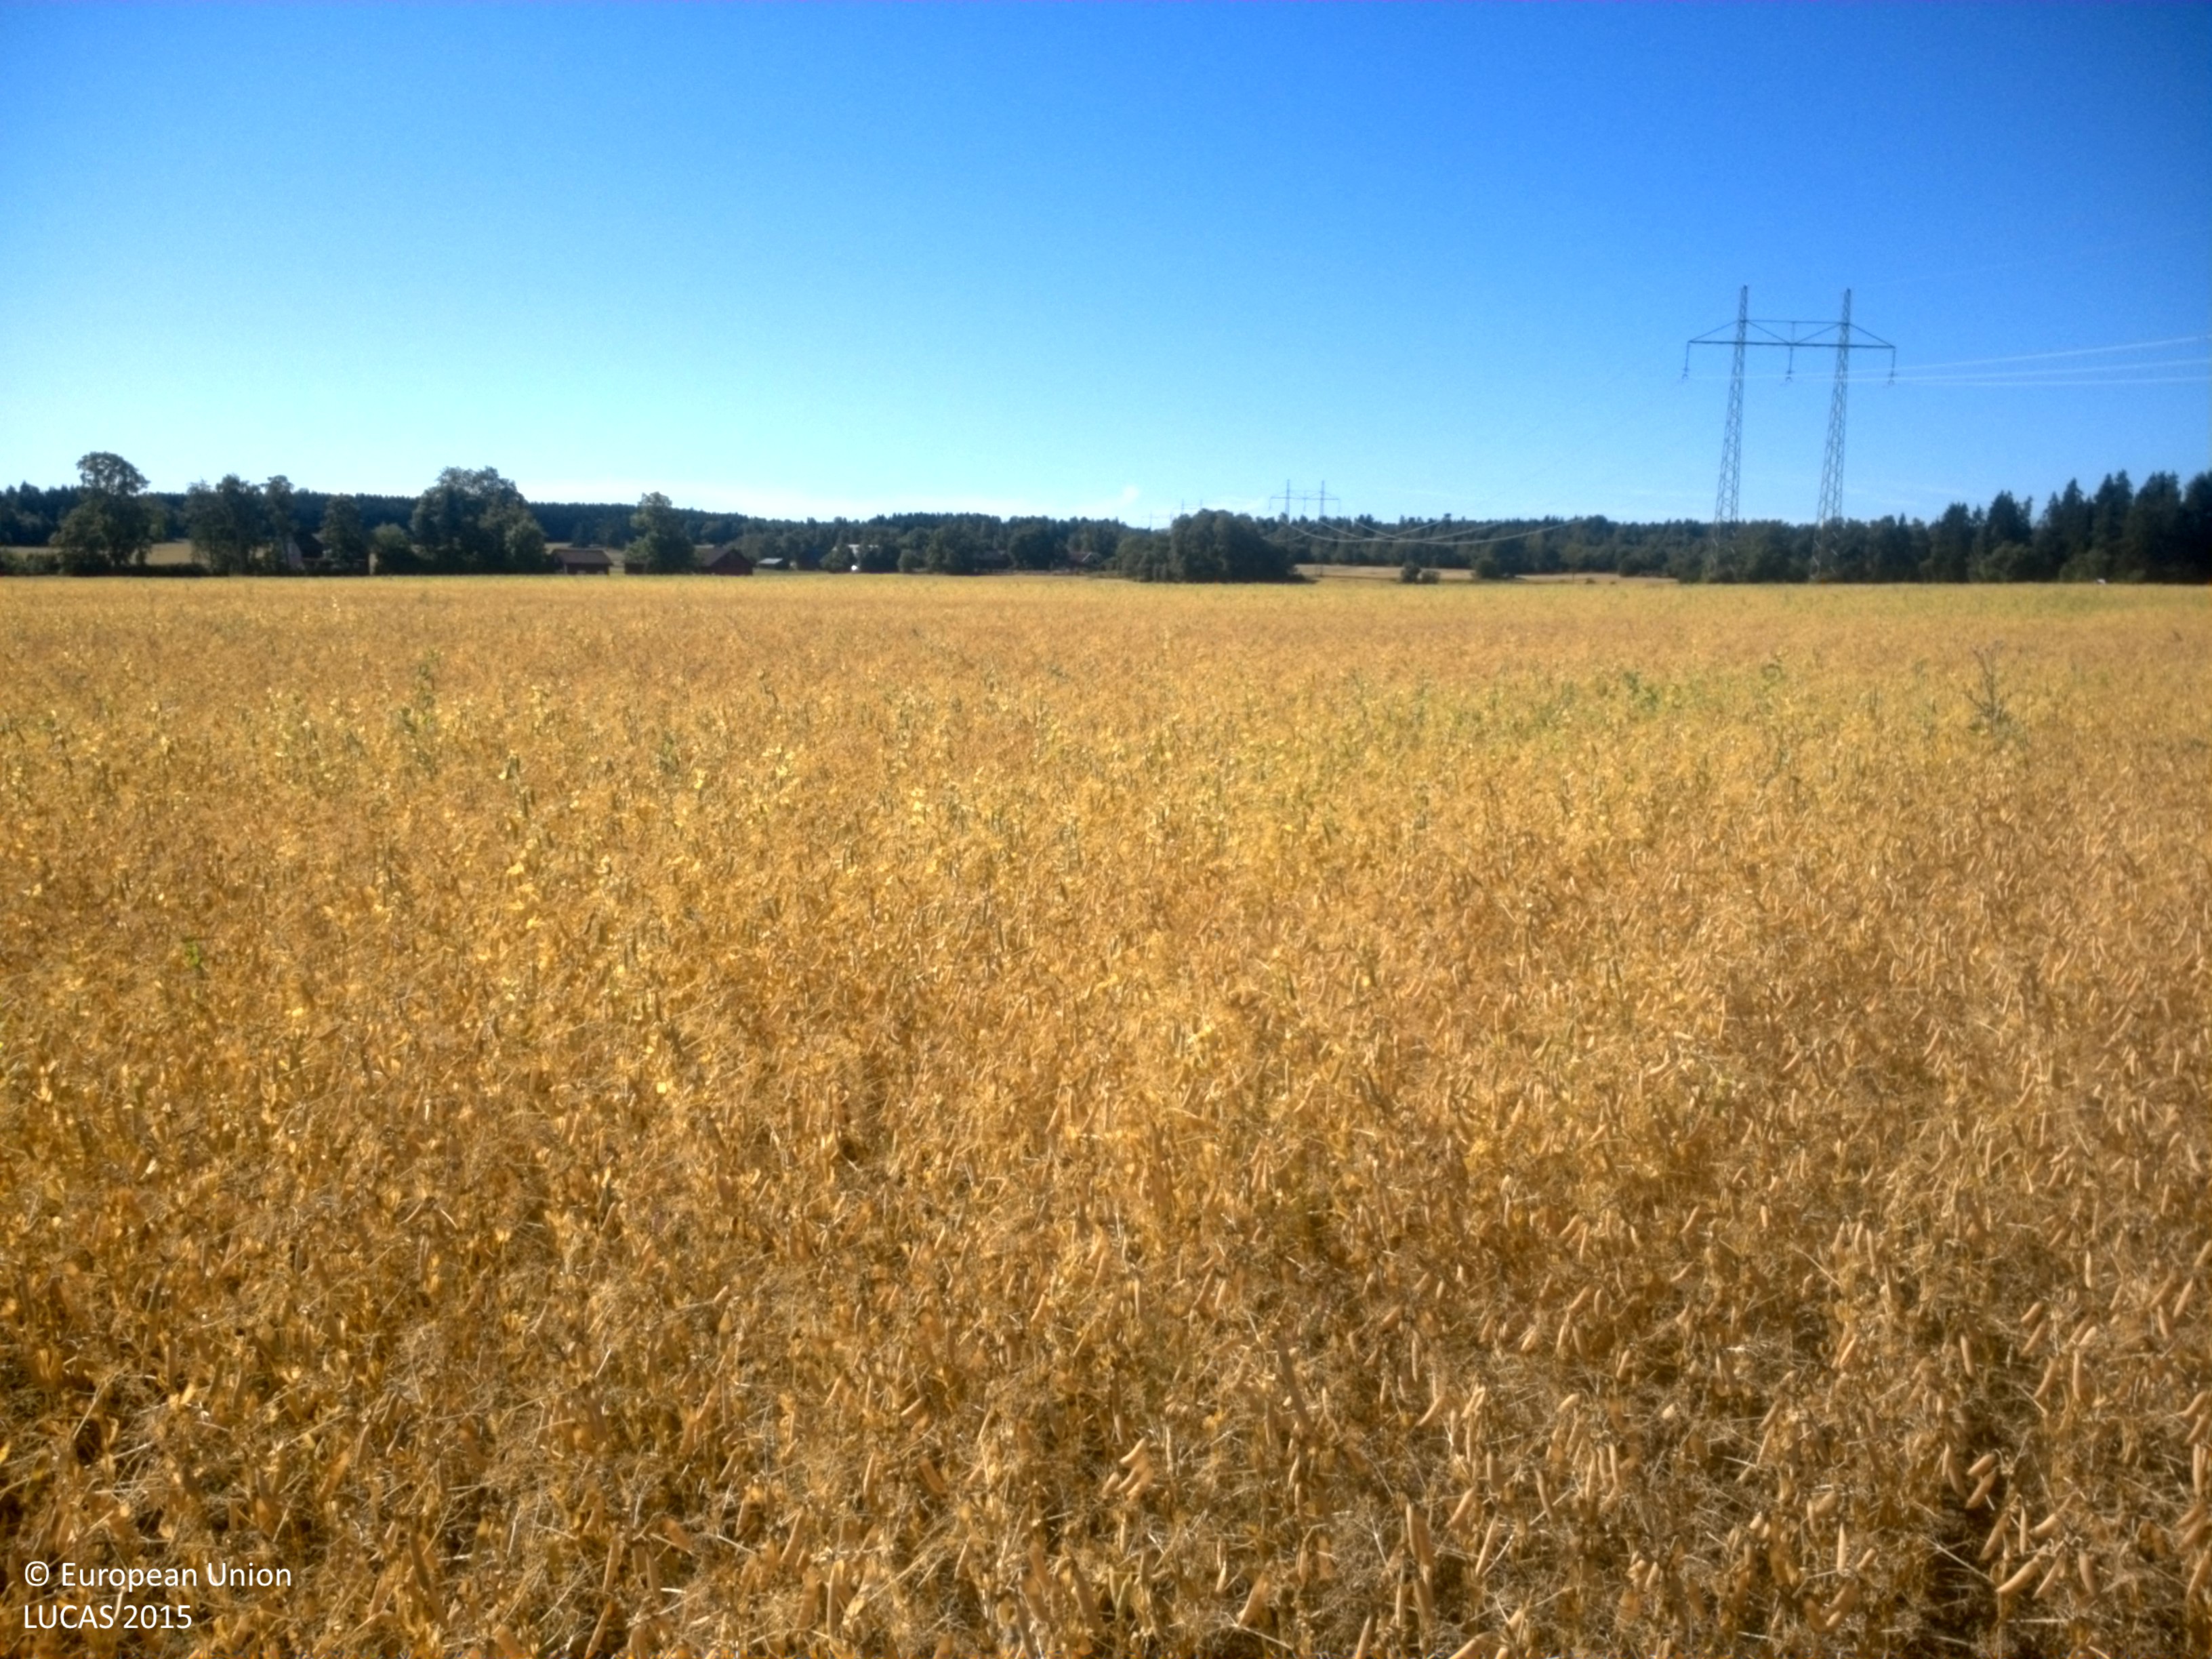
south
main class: Cropland
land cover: Dry pulses
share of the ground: > 75 %
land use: Agriculture (excluding fallow land and kitchen gardens)
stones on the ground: < 10 %
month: August
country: SE
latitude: 59.7239
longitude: 17.2309
